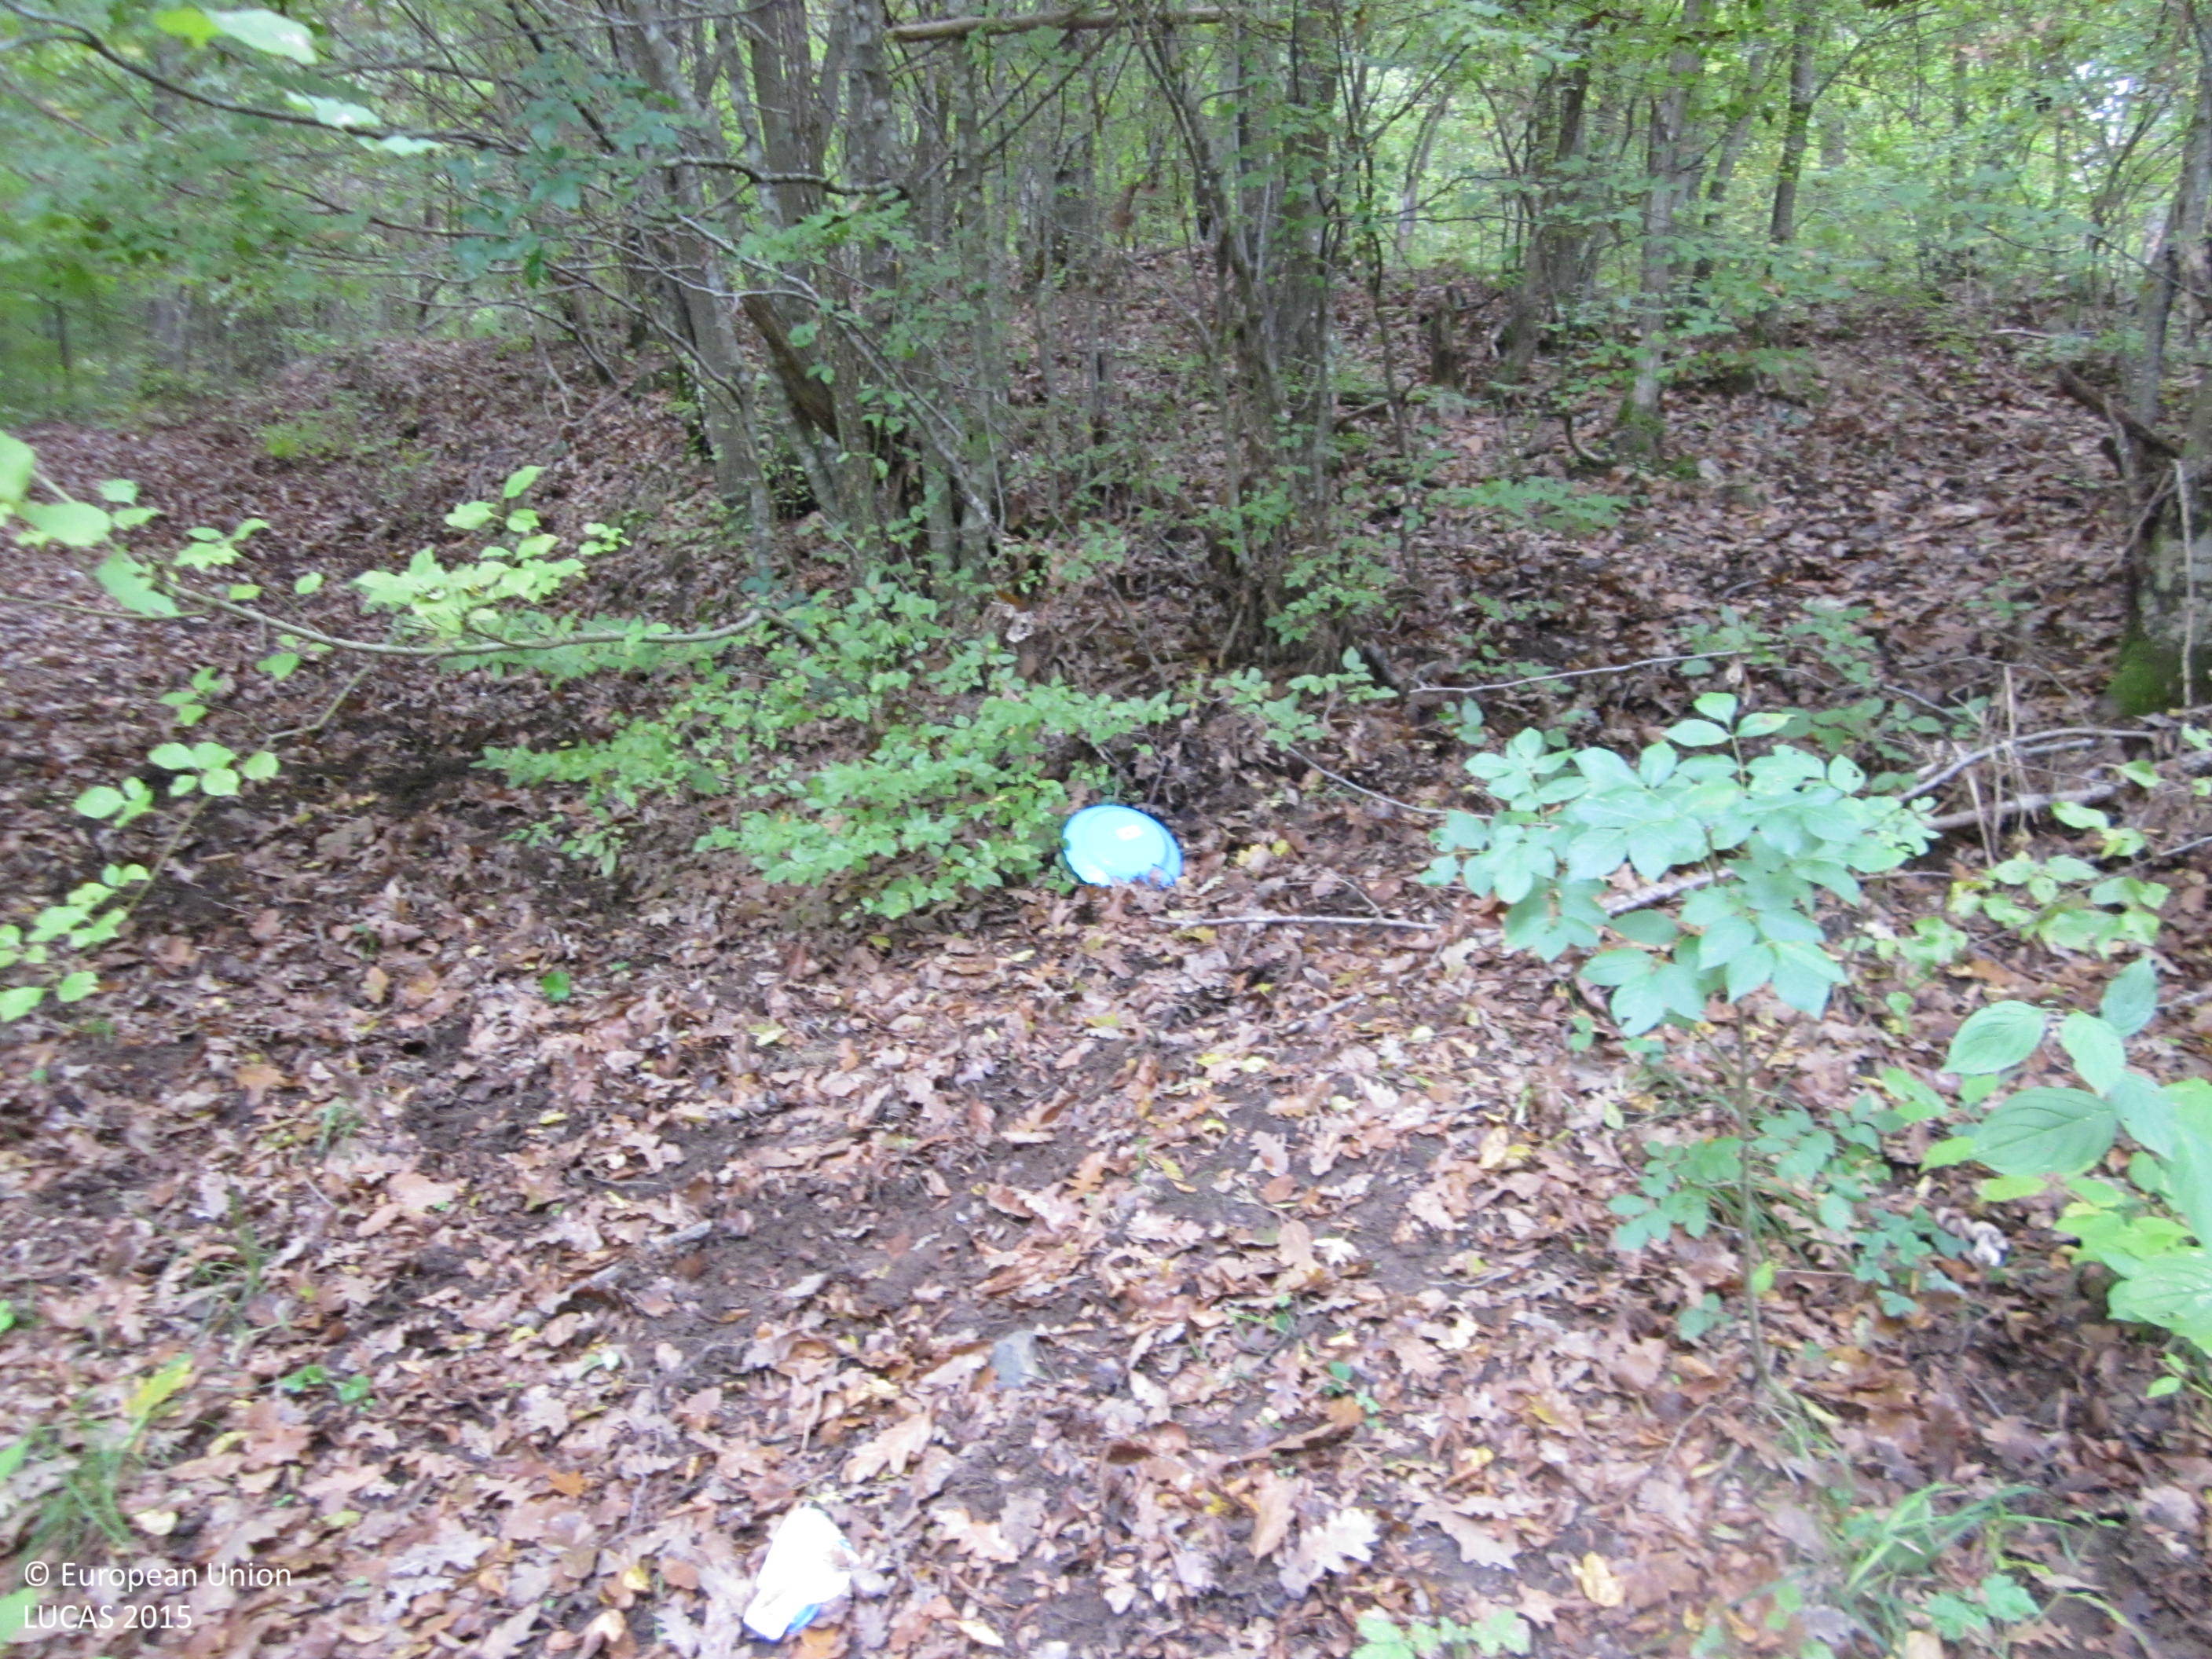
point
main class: Woodland
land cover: Broadleaved woodland
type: mesophytic deciduous forest
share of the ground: > 75 %
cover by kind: broadleaved forest trees 90 %, unconsolidated bare surface 10 %
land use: Forestry
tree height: > 5 m
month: October
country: BG
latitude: 42.2569
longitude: 27.4096
